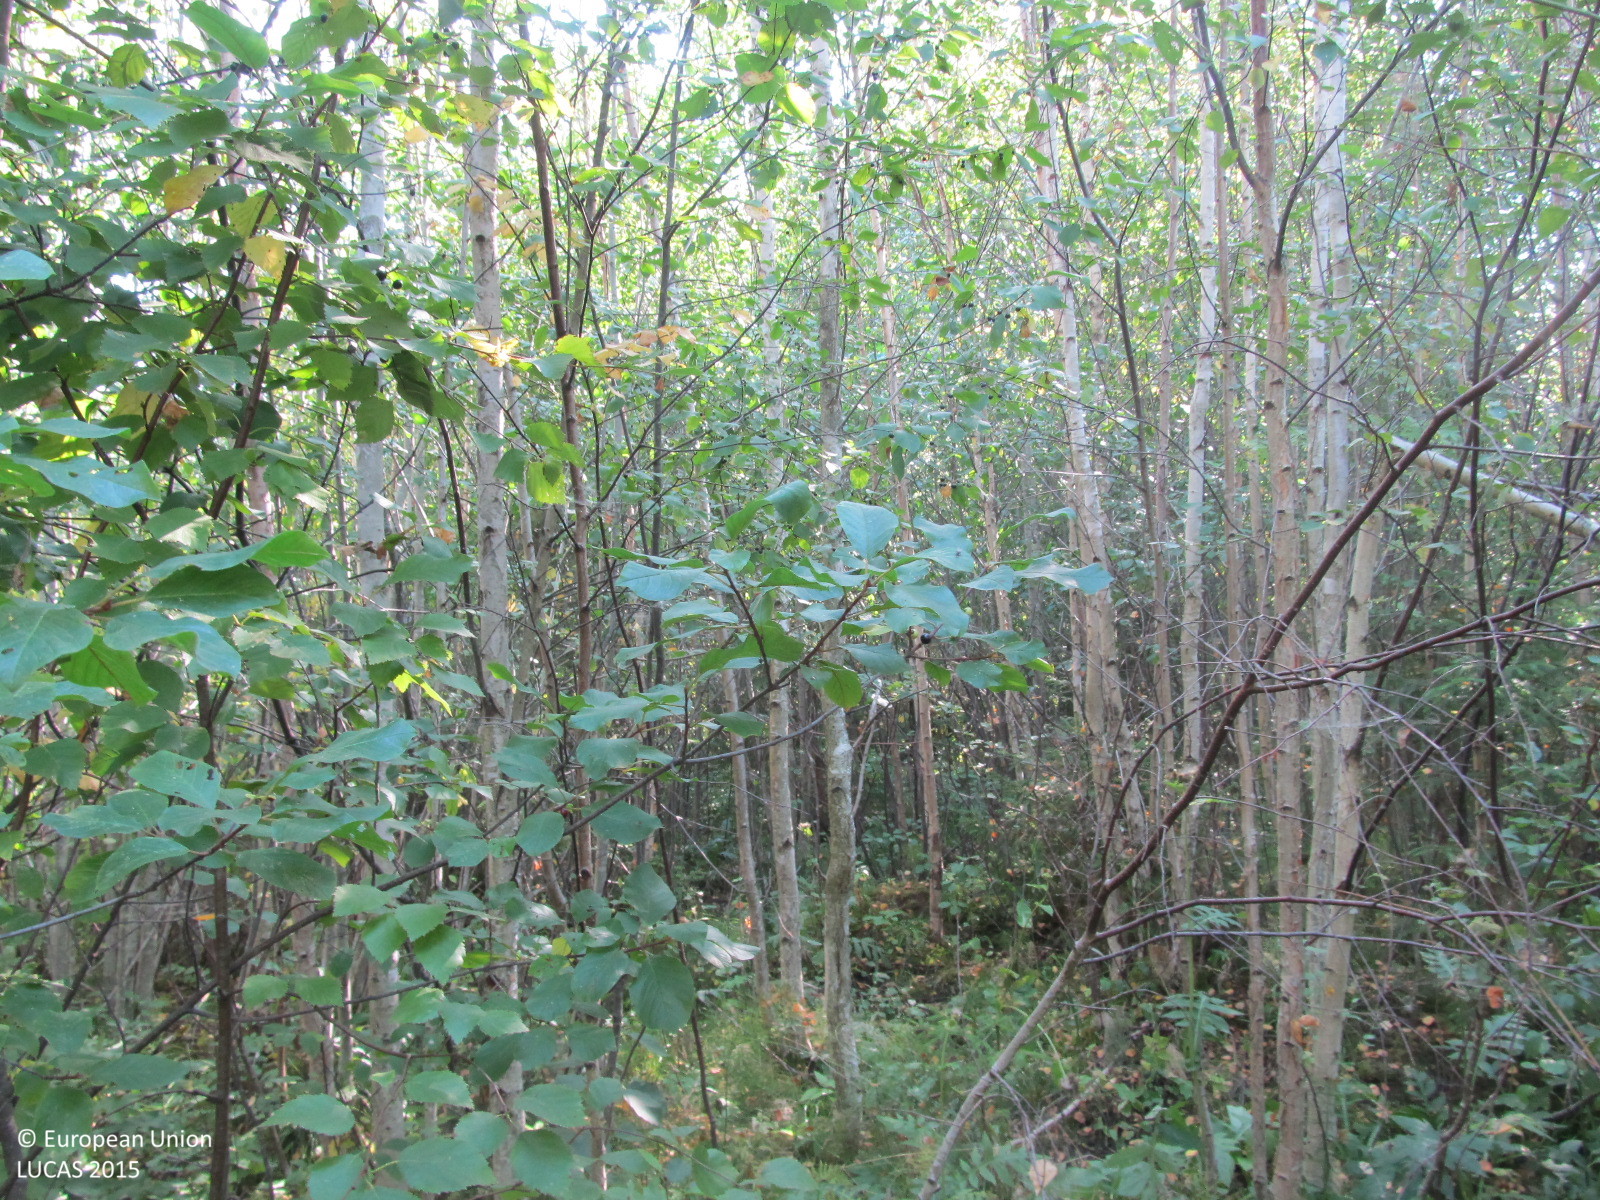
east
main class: Woodland
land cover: Broadleaved woodland
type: non-riverine alder, birch or aspen forest
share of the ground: > 75 %
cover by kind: broadleaved forest trees 80 %, herbaceous plants 20 %
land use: Forestry
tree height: < 5 m
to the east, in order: Broadleaved woodland; Spruce dominated mixed woodland; Broadleaved woodland
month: August
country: LT
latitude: 55.7300
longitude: 23.1124
